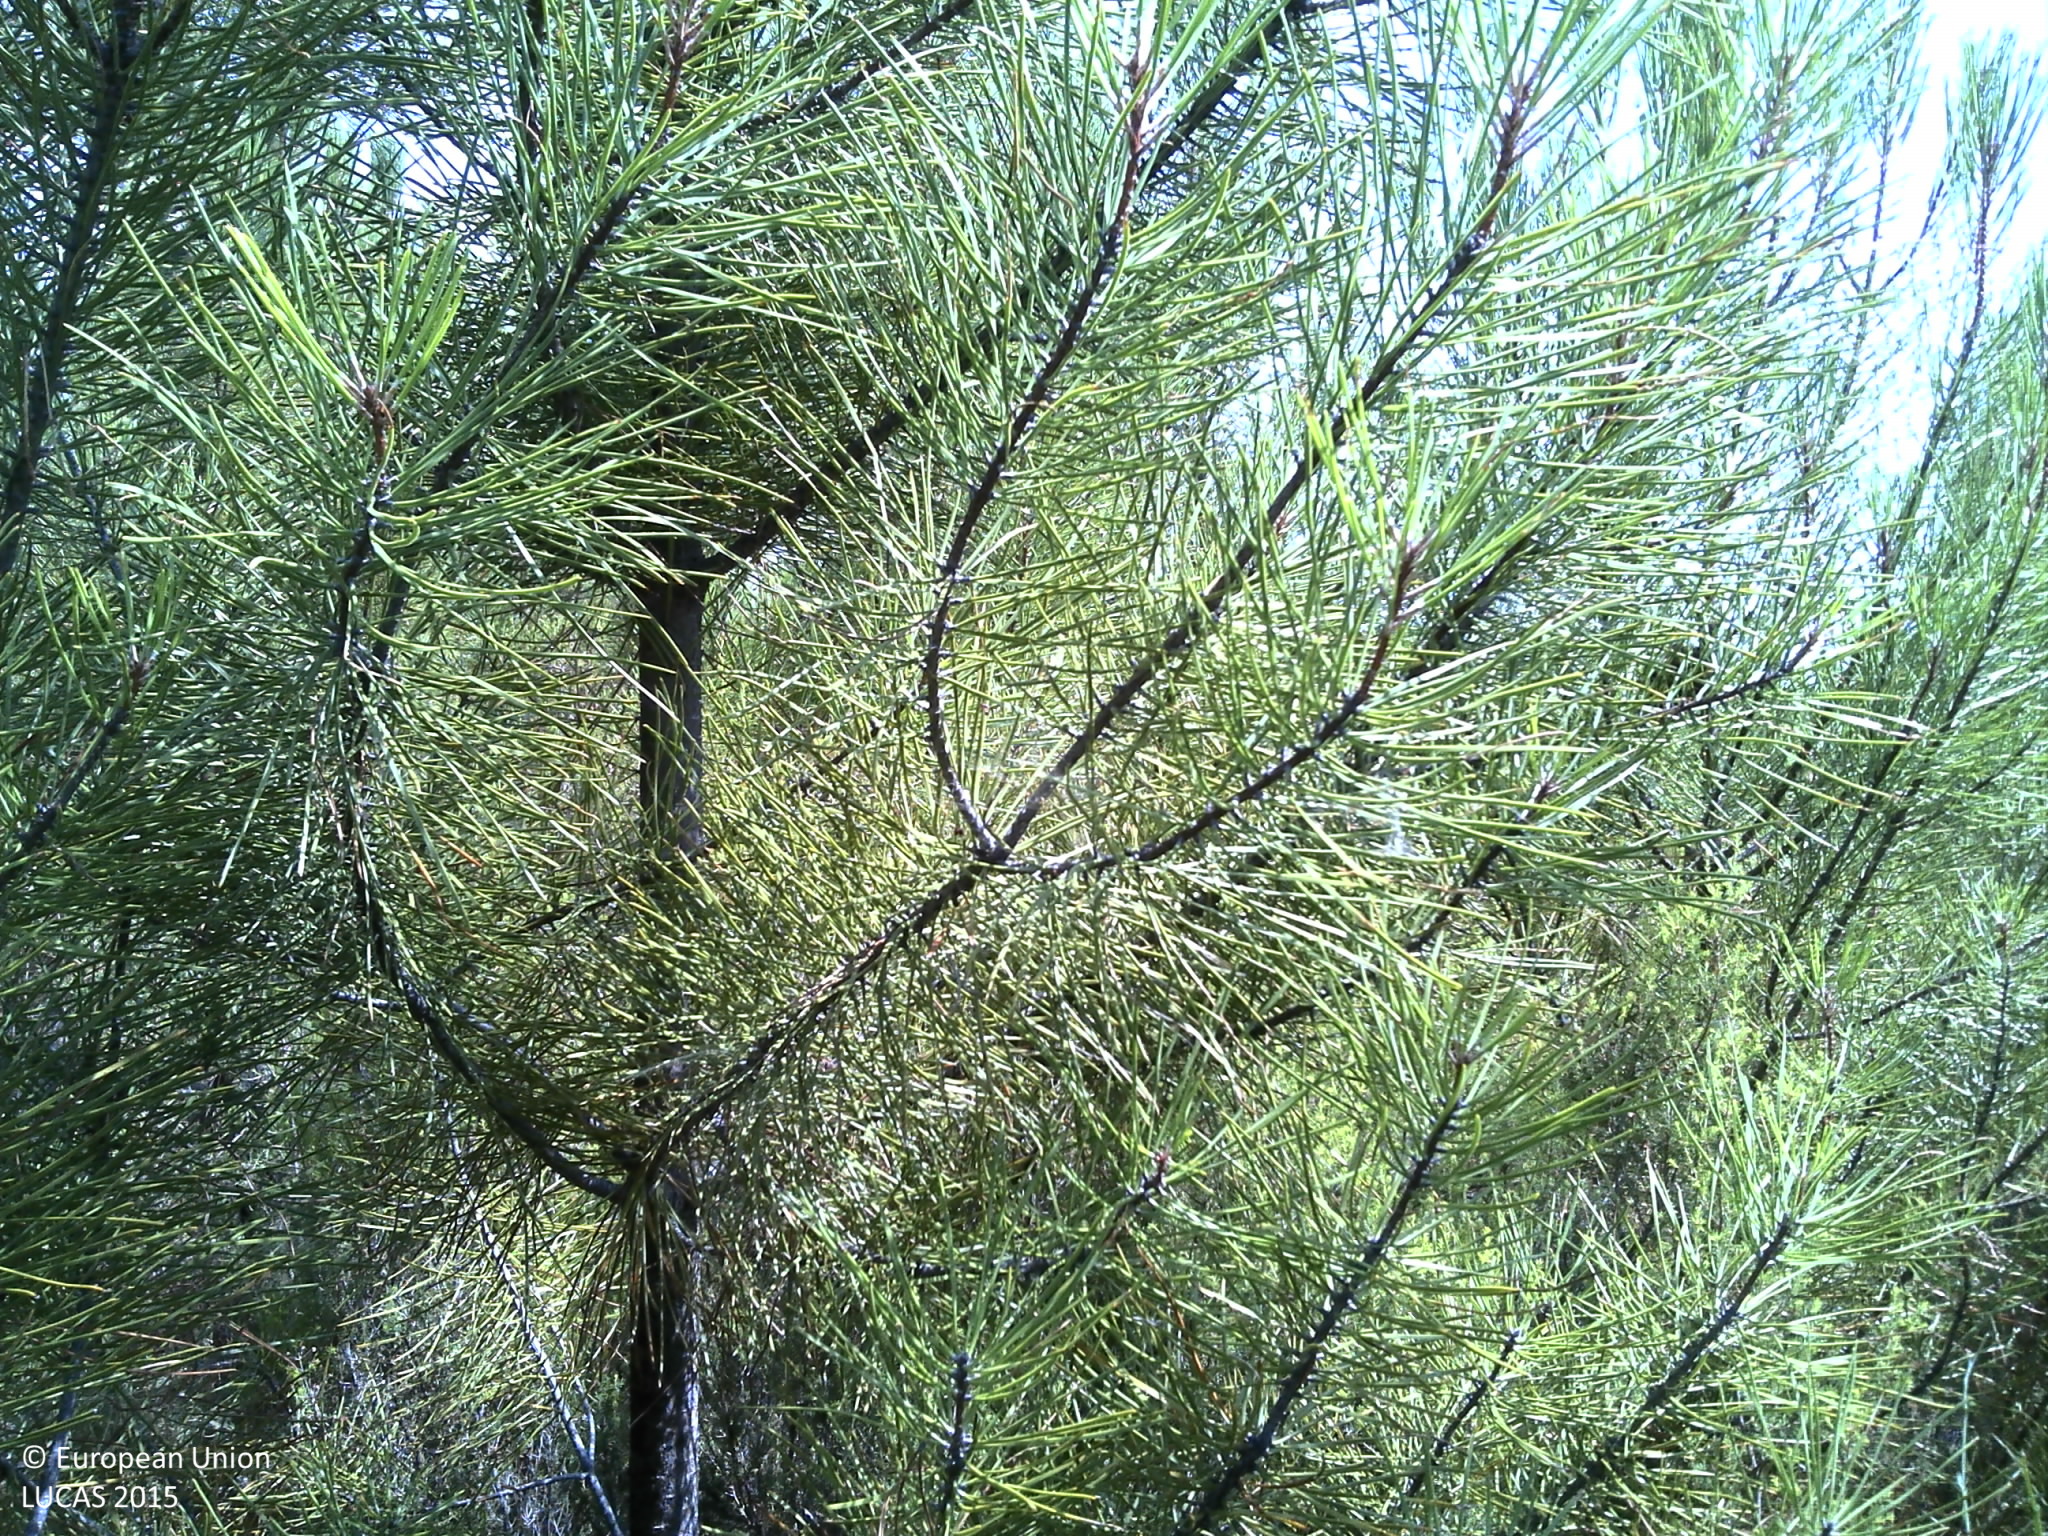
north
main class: Woodland
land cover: Pine dominated coniferous woodland
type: coniferous forest of the mediterranean region
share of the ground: 50 - 75 %
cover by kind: coniferous forest trees 55 %, unconsolidated bare surface 25 %, shrubs 20 %
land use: Forestry
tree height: < 5 m
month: July
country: PT
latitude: 39.8199
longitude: -7.8299
